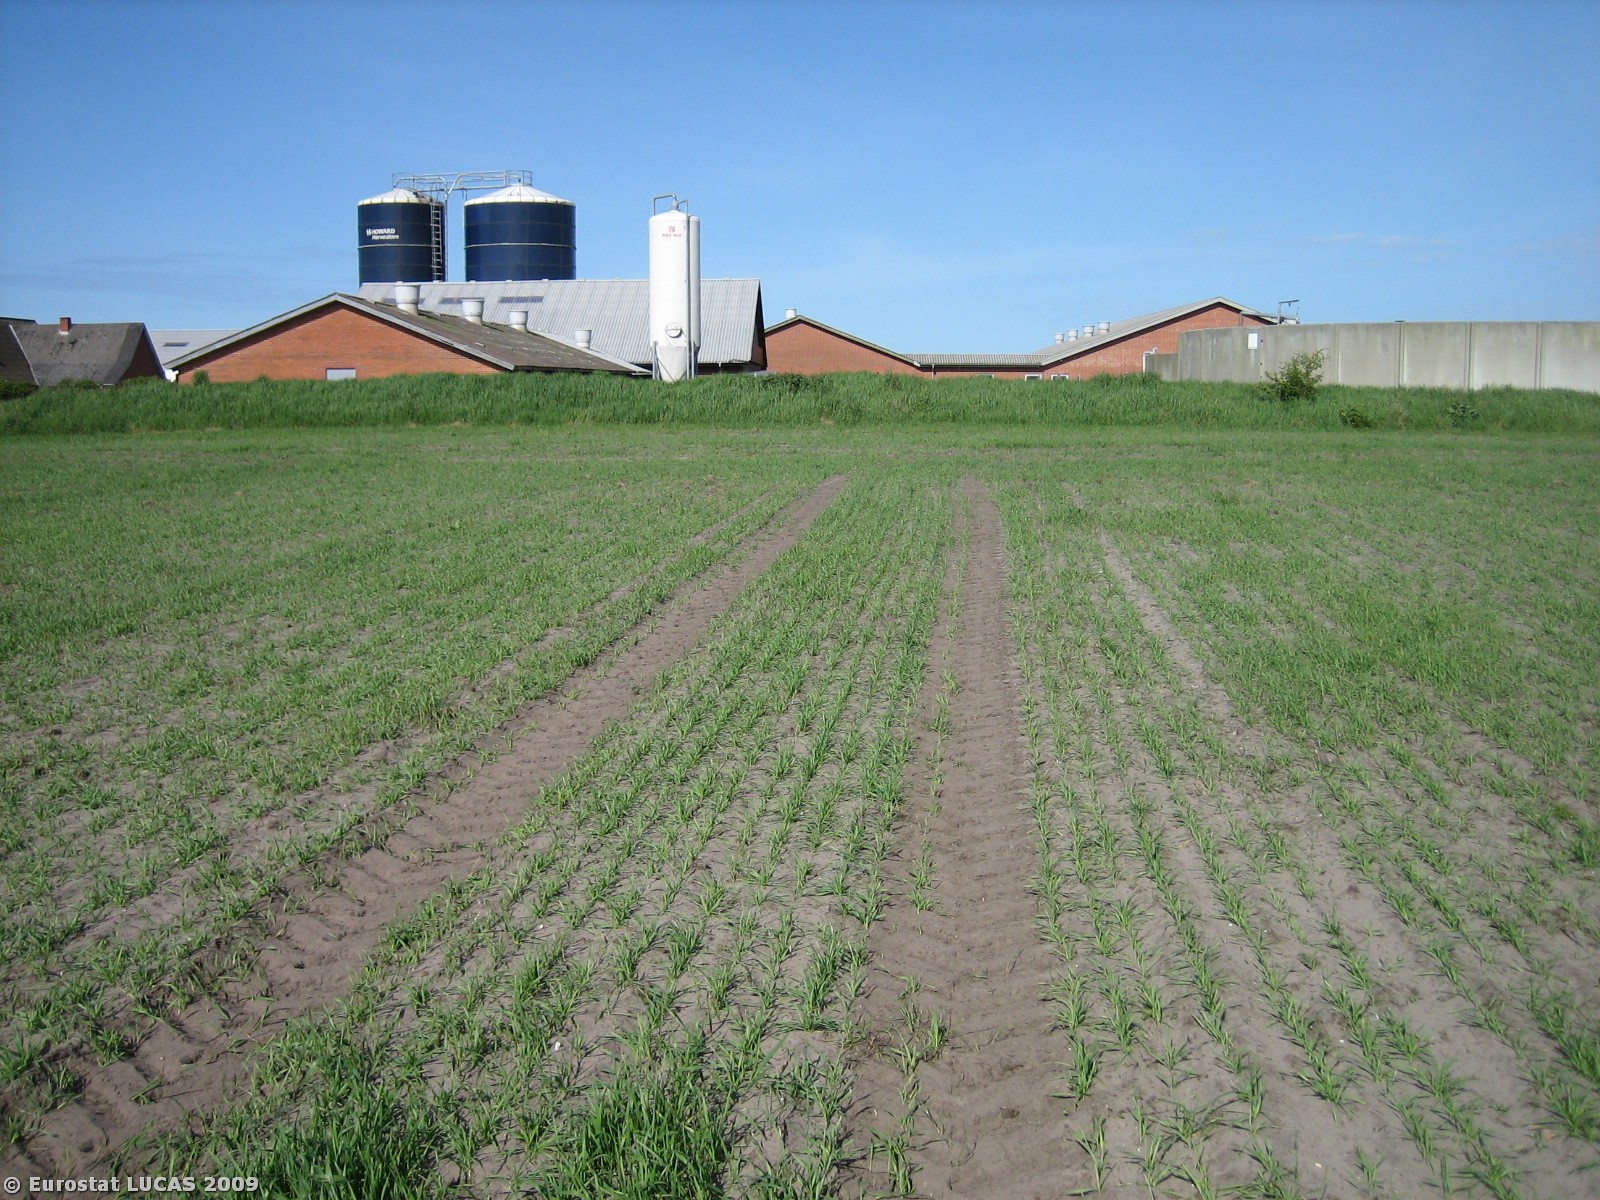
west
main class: Cropland
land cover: Barley
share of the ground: 50 - 75 %
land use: Agriculture (excluding fallow land and kitchen gardens)
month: May
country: DK
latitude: 56.1403
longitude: 8.2799
